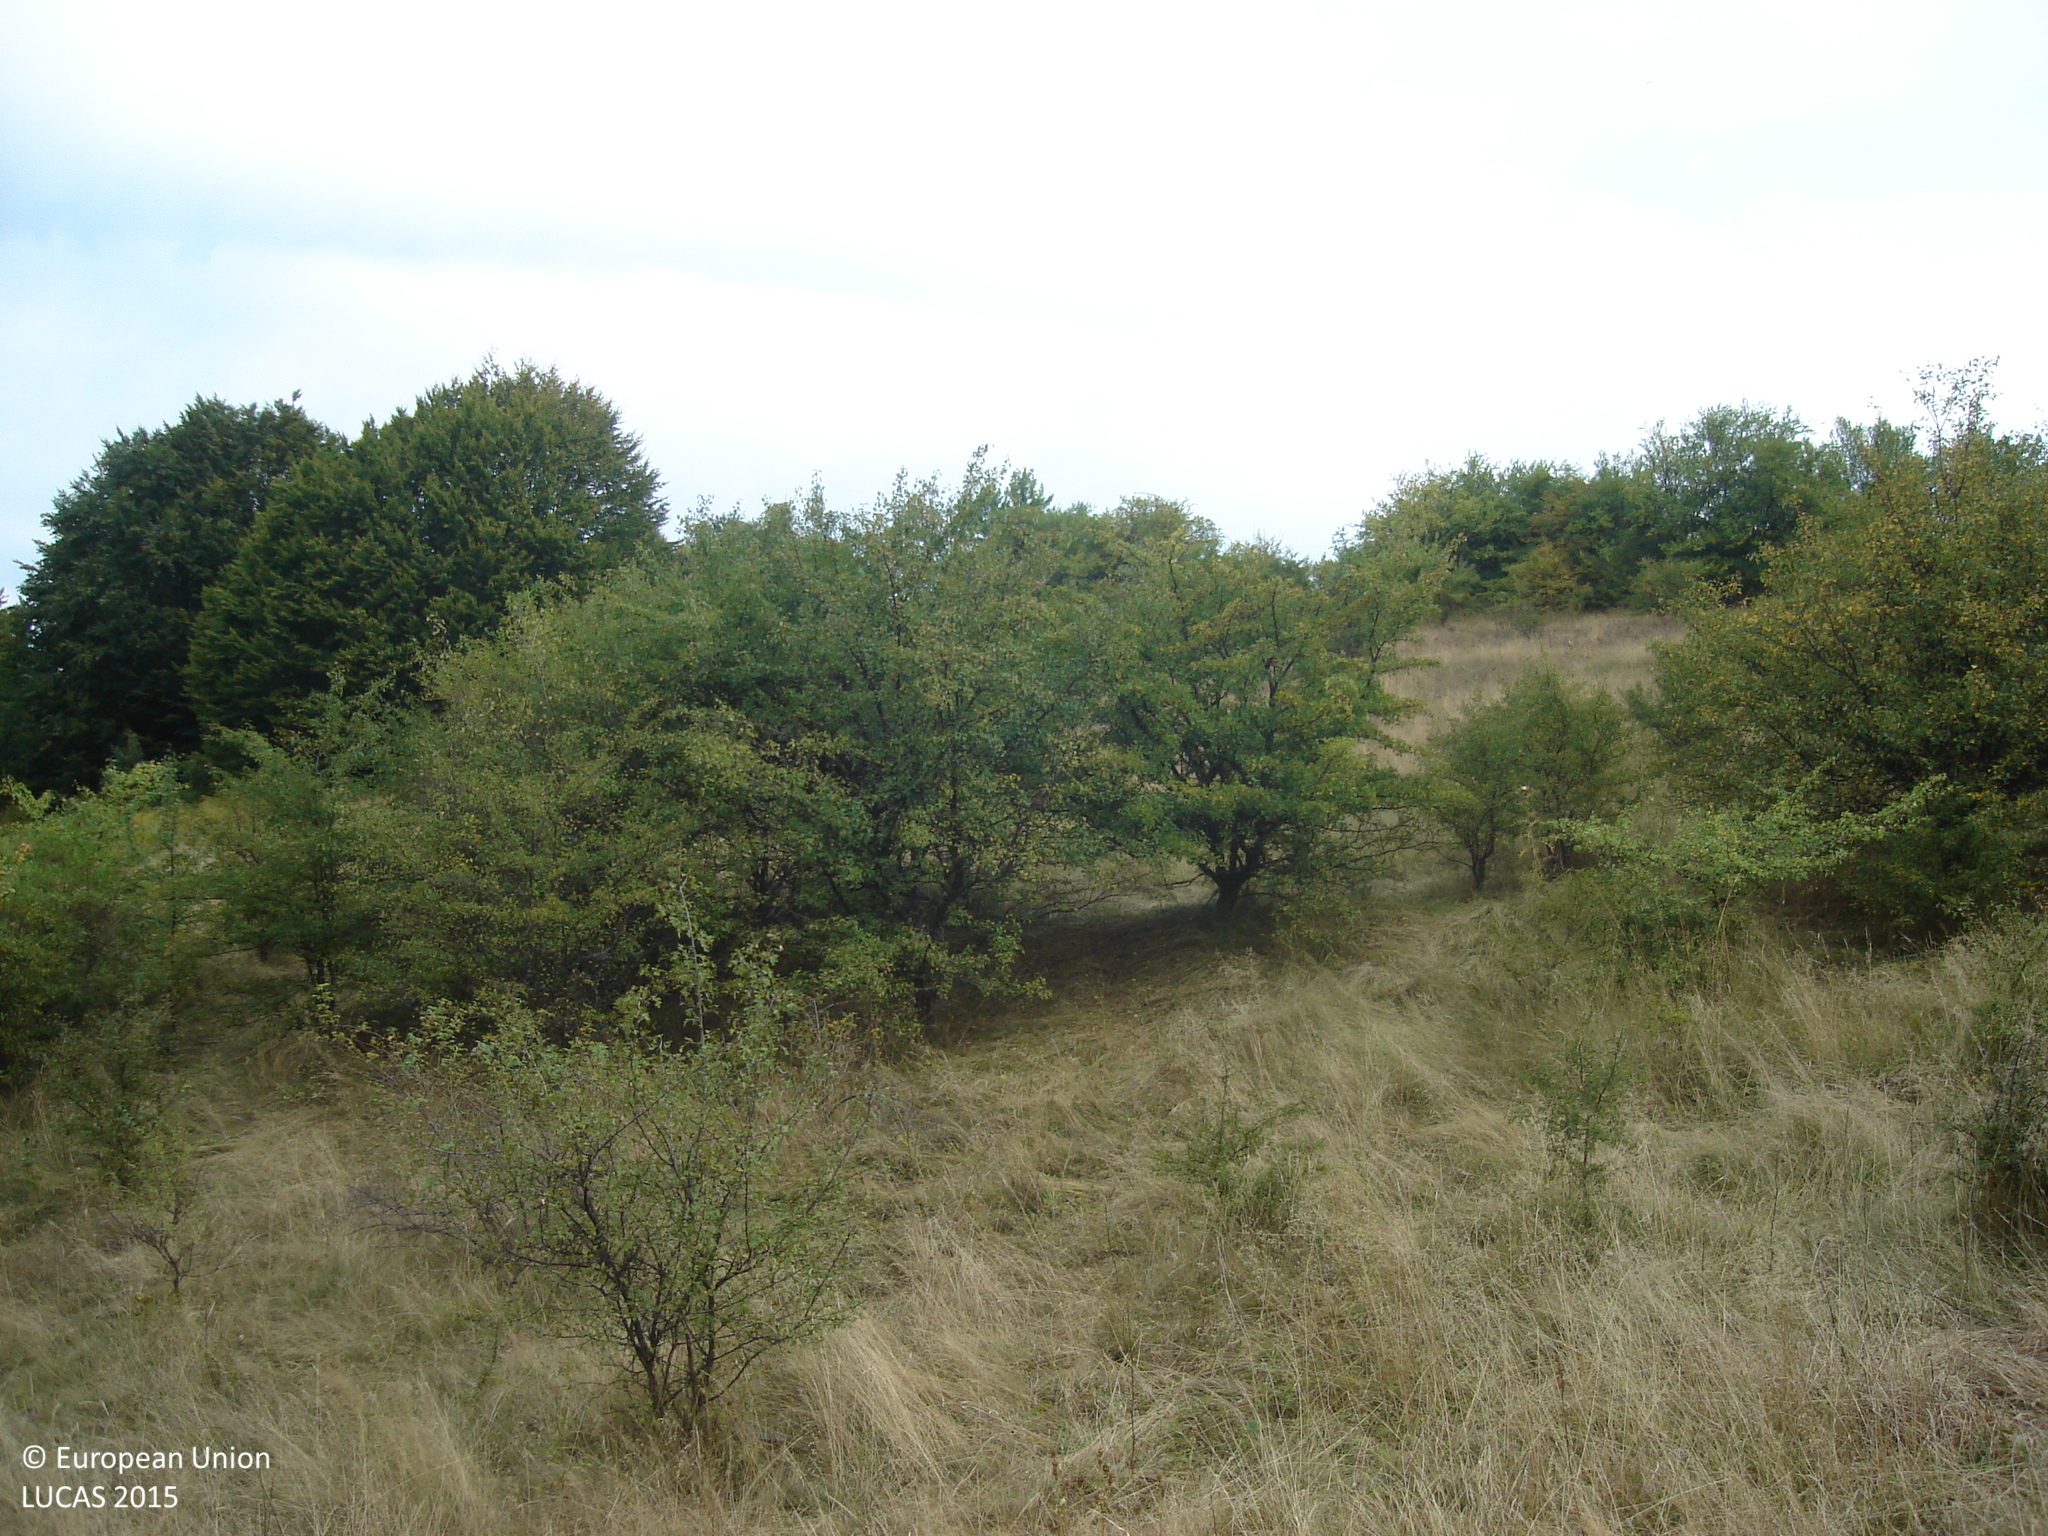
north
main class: Grassland
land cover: Grassland without tree/shrub cover
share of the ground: > 75 %
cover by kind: herbaceous plants 95 %, shrubs 5 %
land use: Agriculture (excluding fallow land and kitchen gardens)
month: September
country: BG
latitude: 42.5408
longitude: 23.8363
